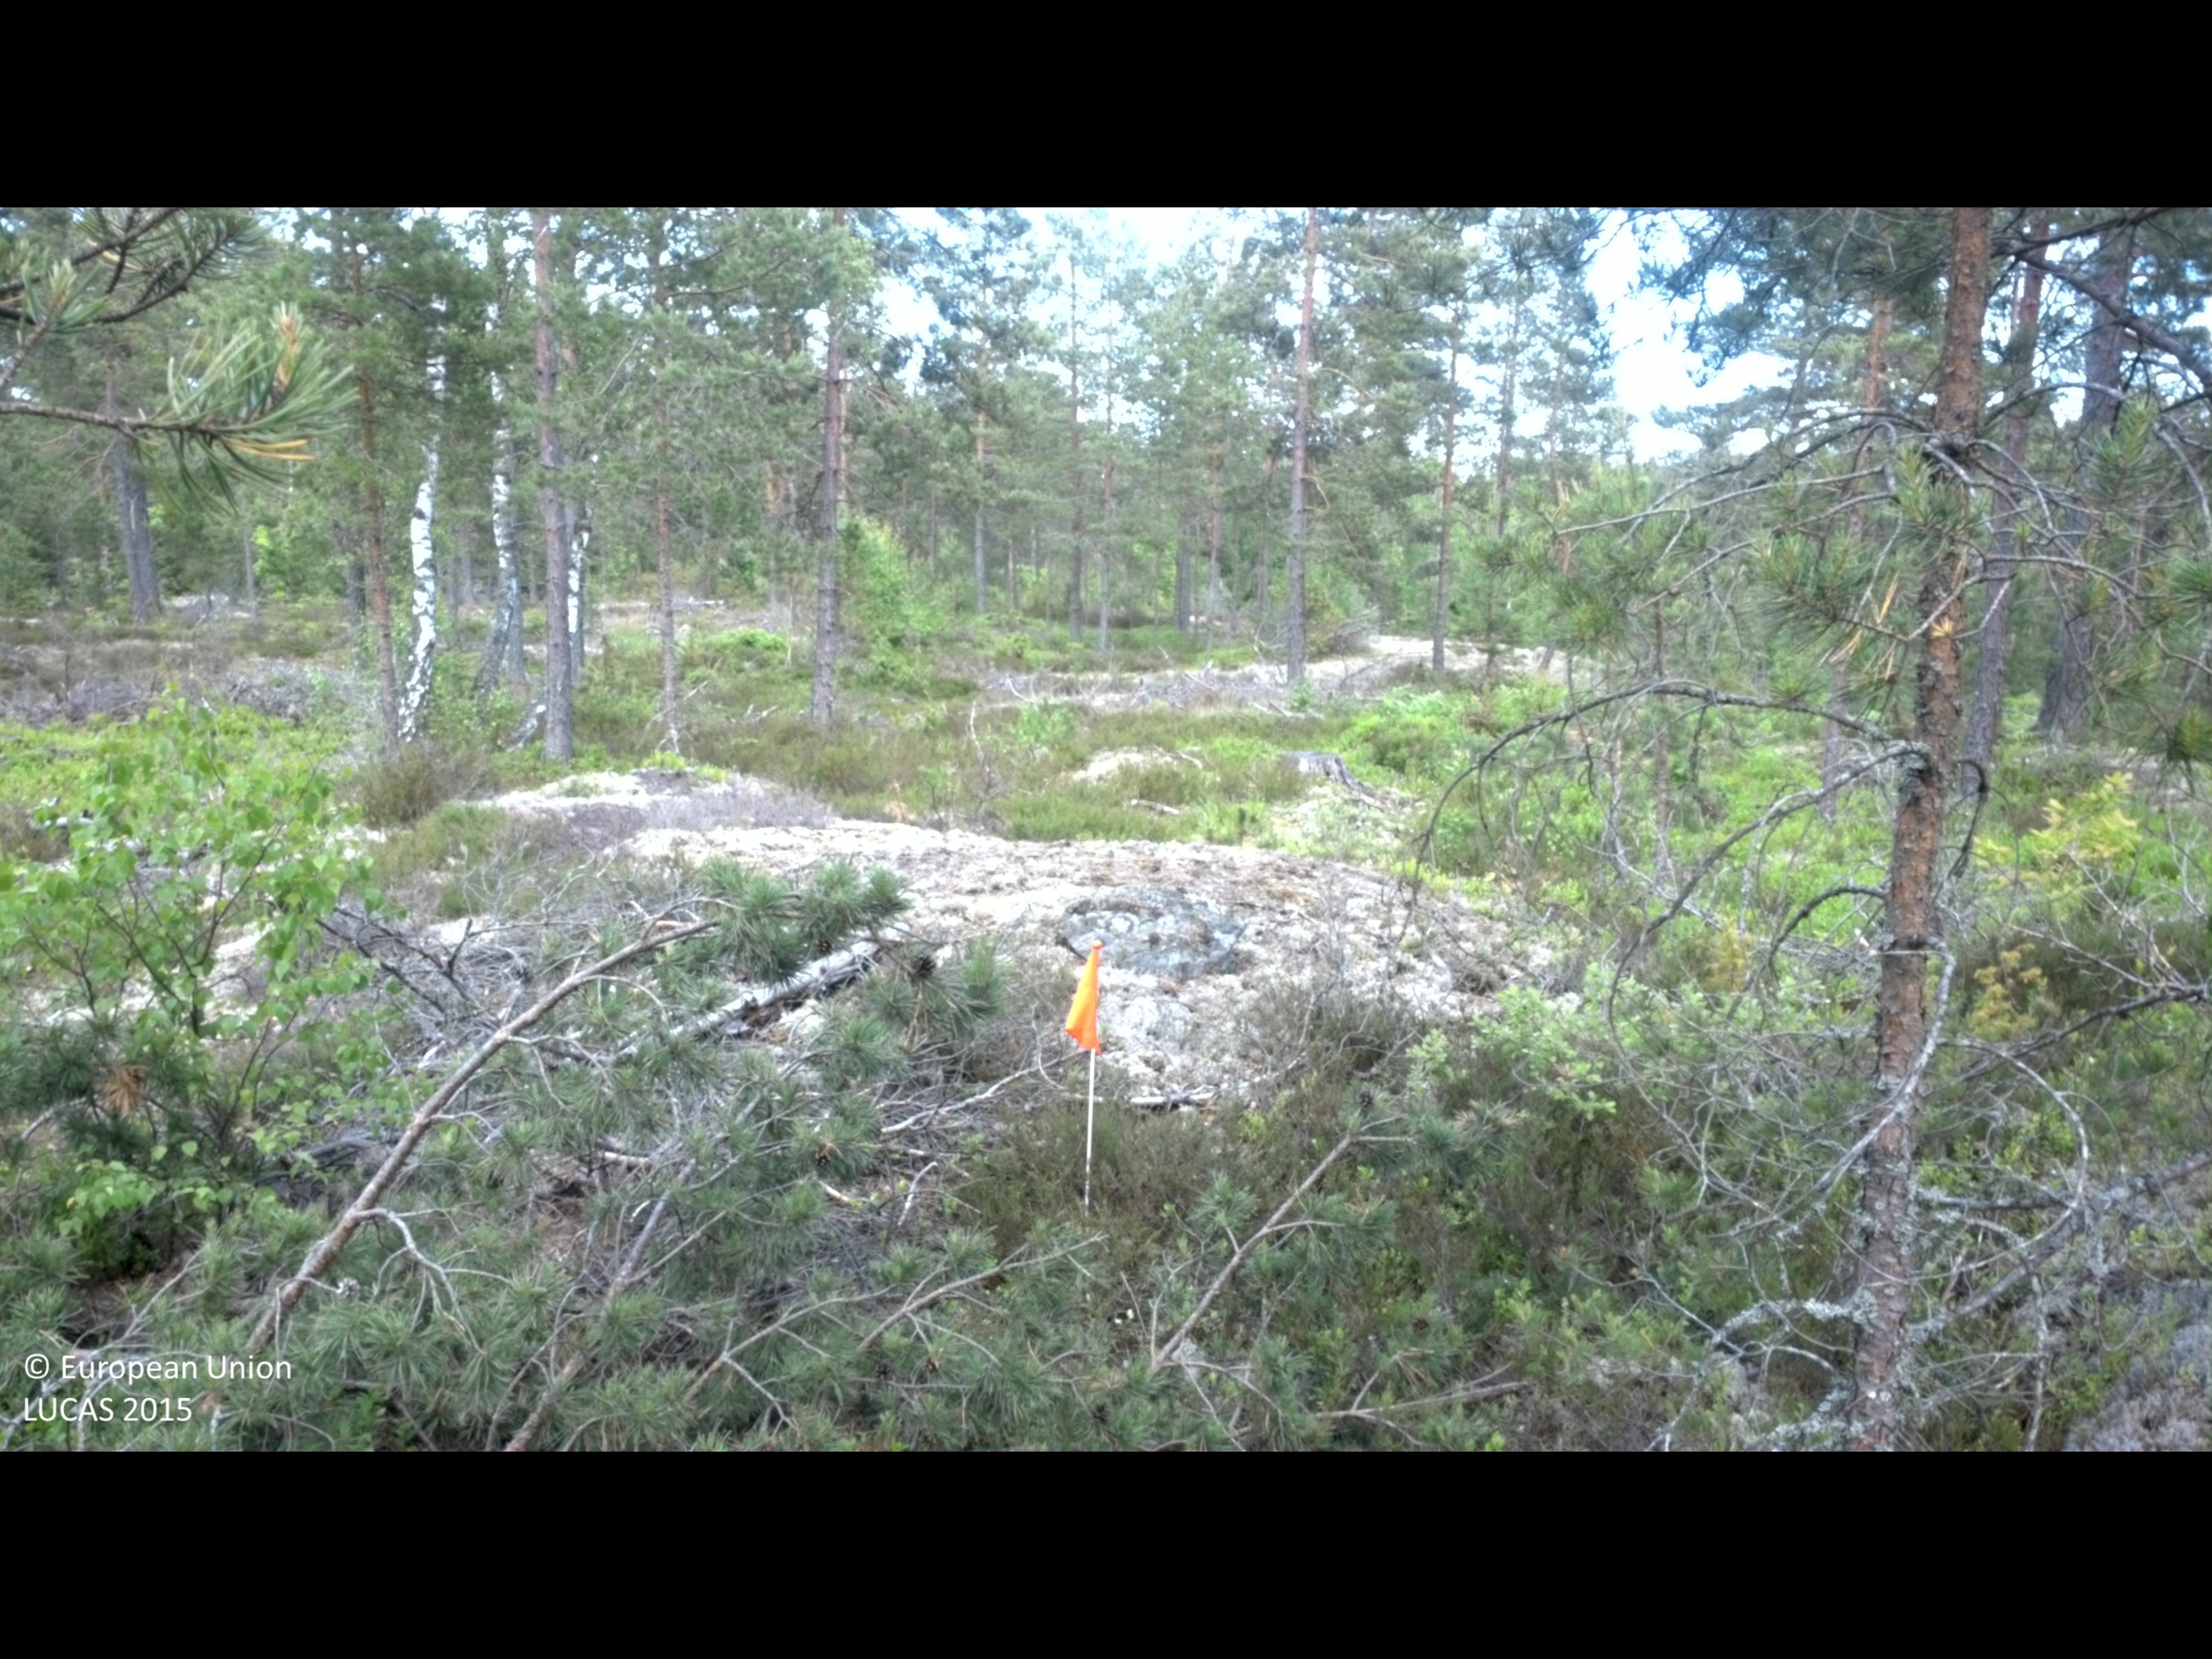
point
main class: Woodland
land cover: Pine dominated coniferous woodland
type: boreal forest
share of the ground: 25 - 50 %
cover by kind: coniferous forest trees 40 %, shrubs 40 %, lichens and mosses 10 %, broadleaved forest trees 5 %, herbaceous plants 5 %
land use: Forestry
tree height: > 5 m
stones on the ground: < 10 %
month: June
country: SE
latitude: 57.6788
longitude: 16.5893
